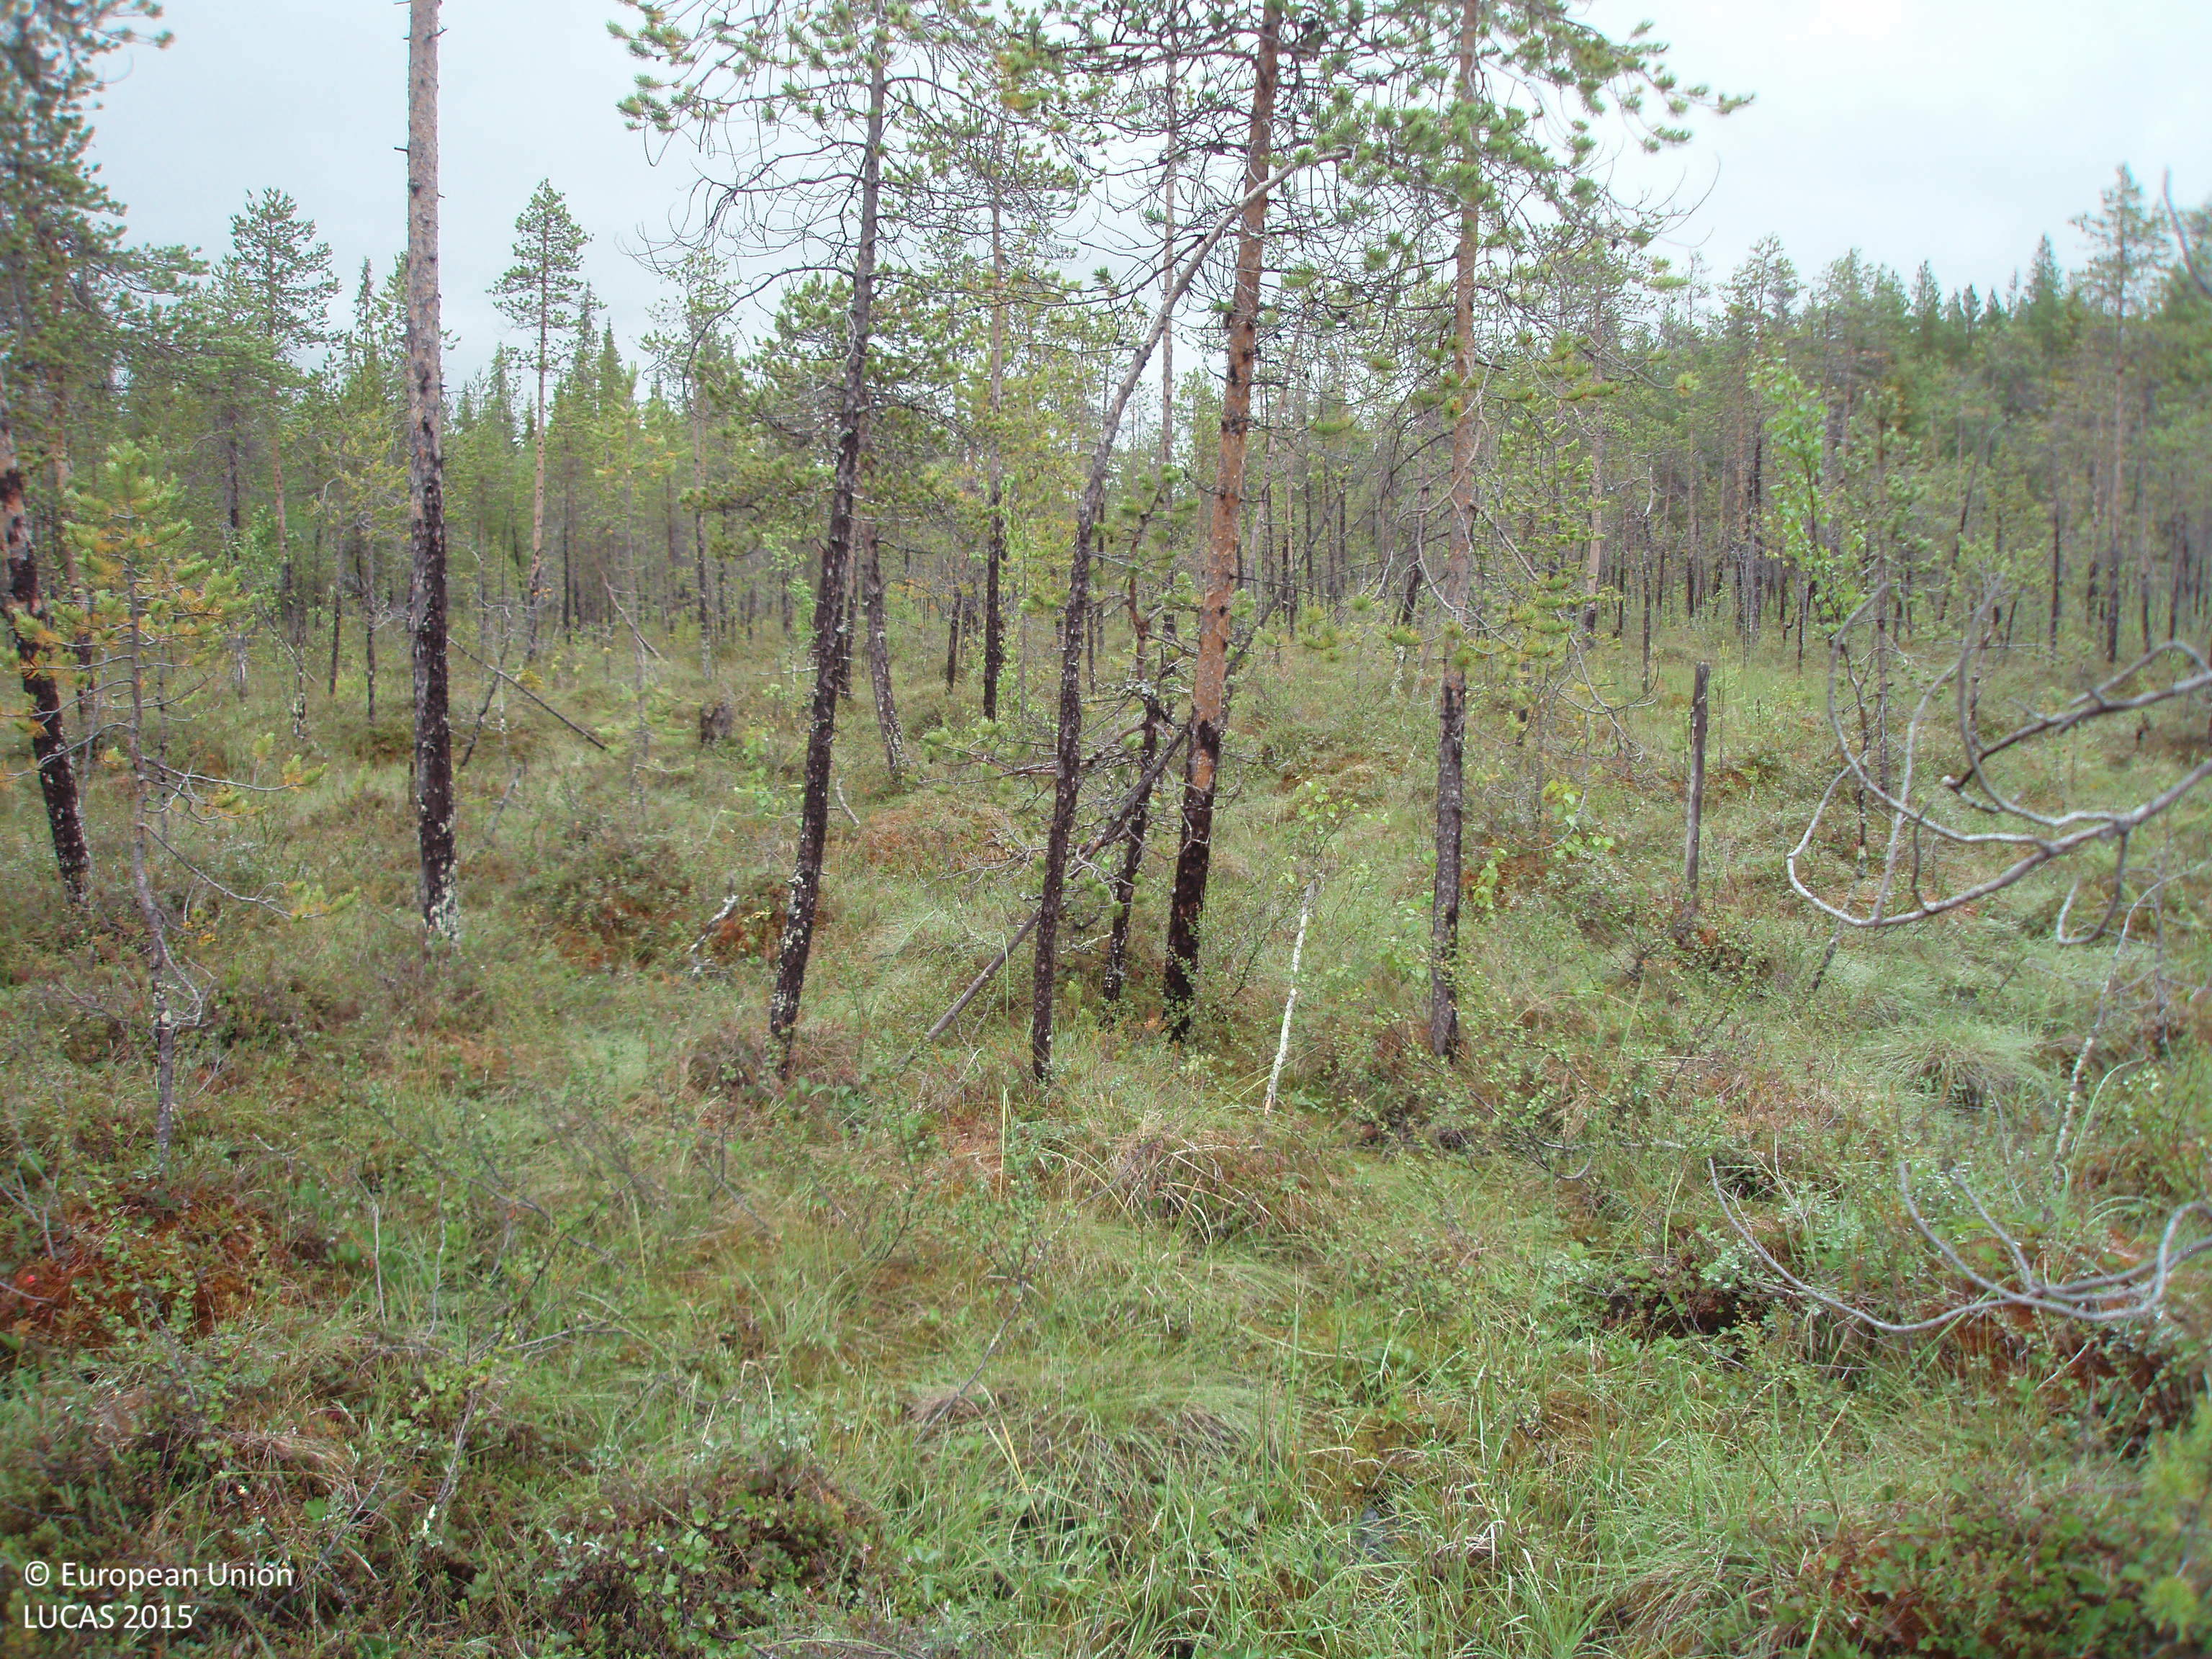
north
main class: Woodland
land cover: Pine dominated coniferous woodland
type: mire and swamp forests
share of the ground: 25 - 50 %
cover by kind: shrubs 70 %, coniferous forest trees 30 %
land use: Semi-natural and natural areas not in use
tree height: > 5 m
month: July
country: FI
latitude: 67.1717
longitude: 28.6403
